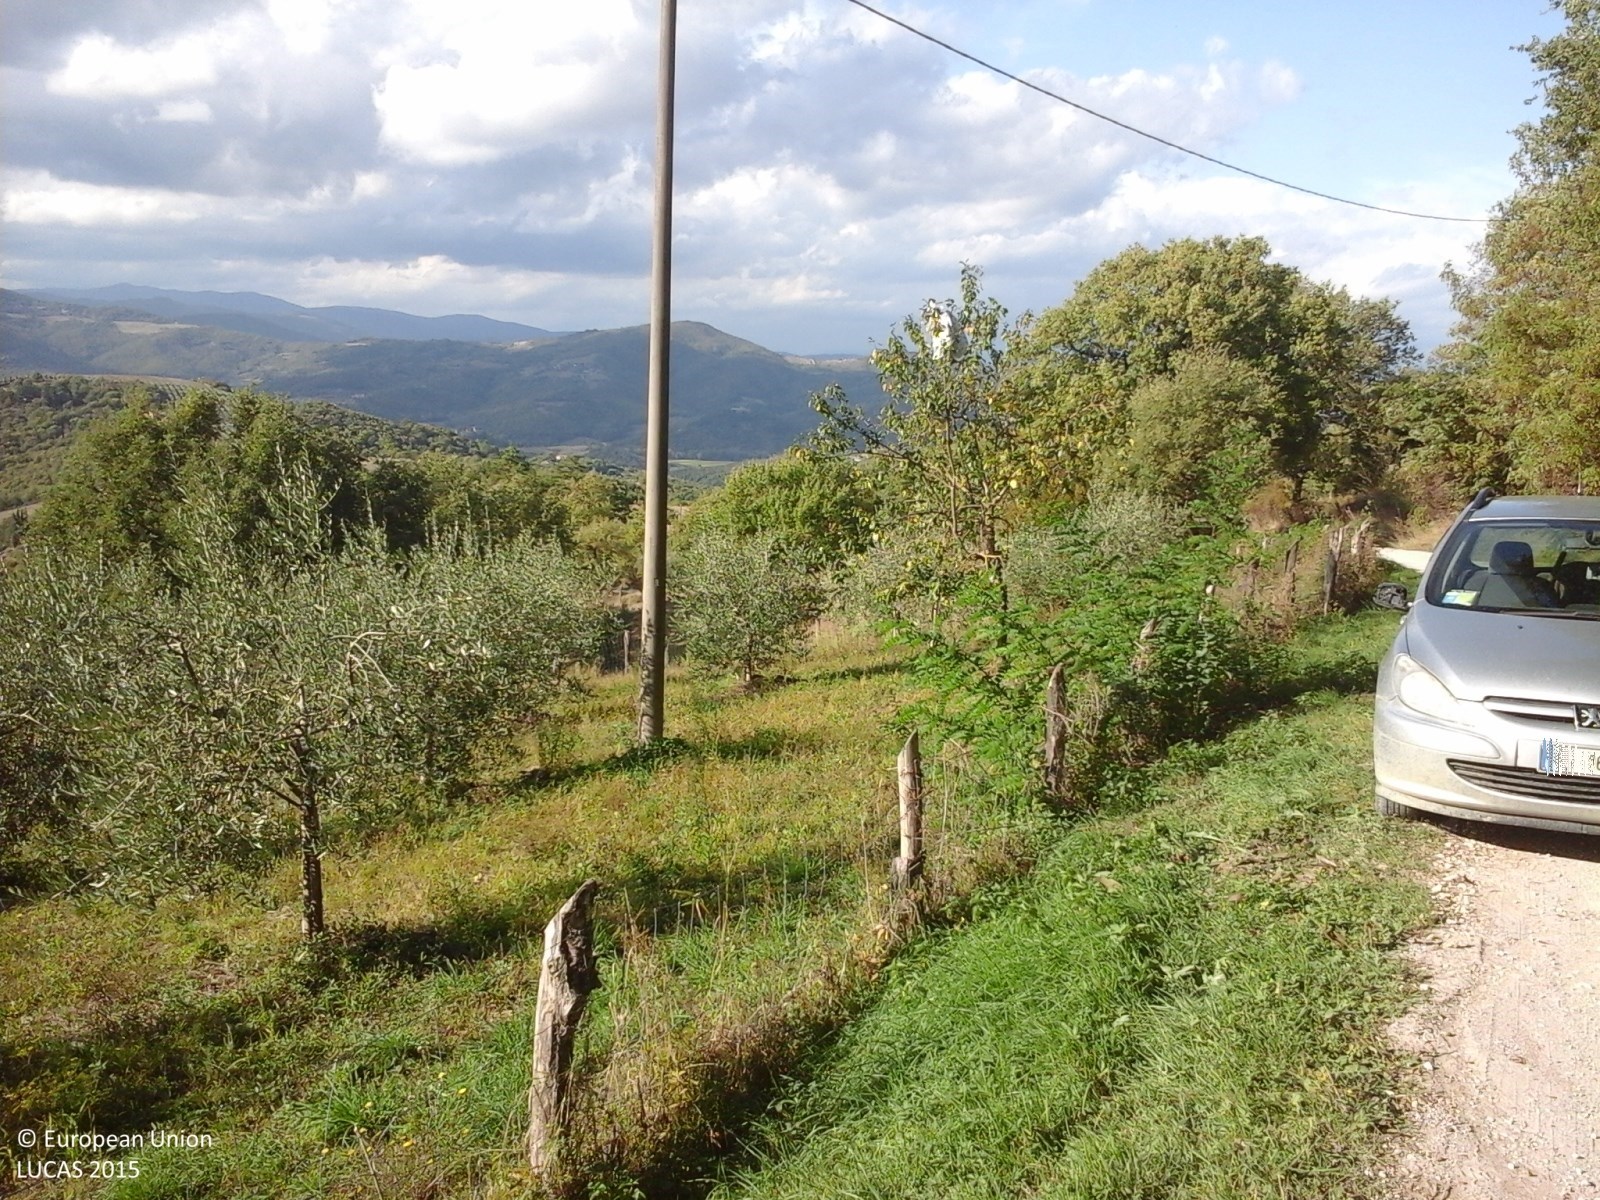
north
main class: Cropland
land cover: Olive groves
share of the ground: 50 - 75 %
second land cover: Spontaneously vegetated surfaces
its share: > 75 %
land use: Agriculture (excluding fallow land and kitchen gardens)
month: October
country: IT
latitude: 43.2438
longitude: 12.2228
